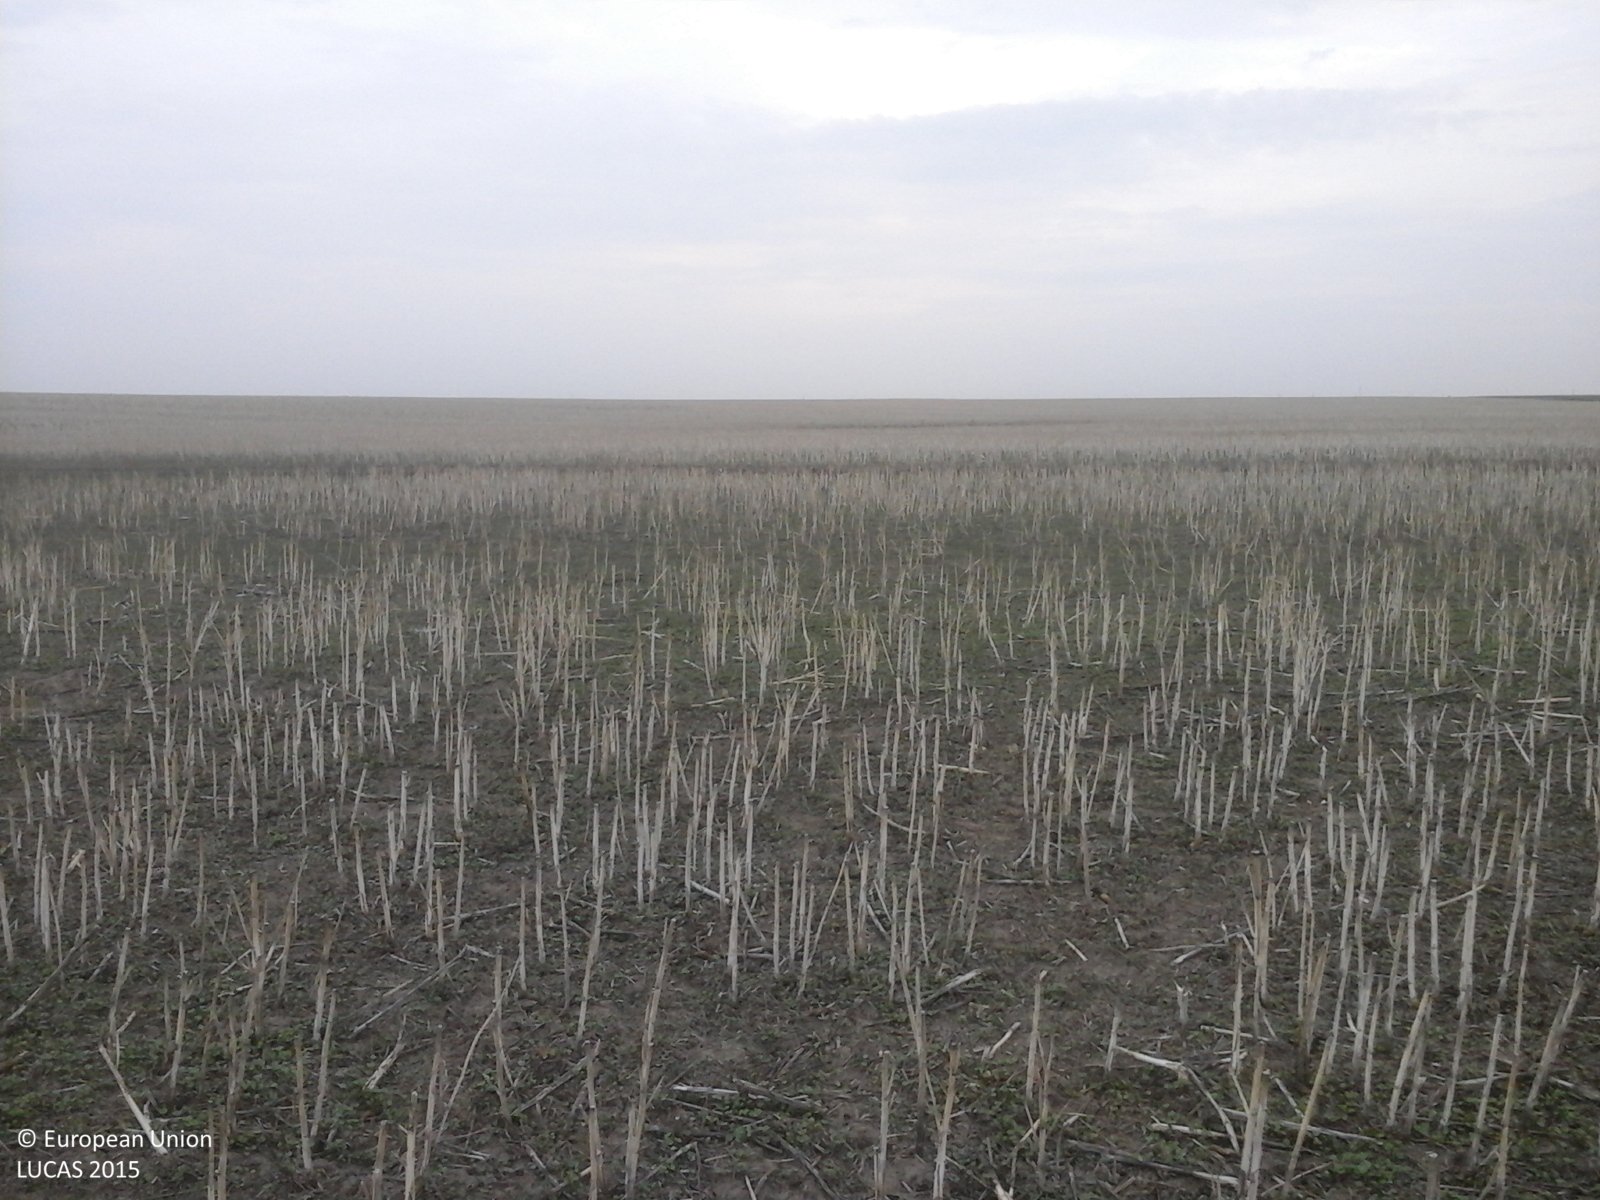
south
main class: Cropland
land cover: Rape and turnip rape
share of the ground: 10 - 25 %
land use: Agriculture (excluding fallow land and kitchen gardens)
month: August
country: RO
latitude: 46.2270
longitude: 21.4322
